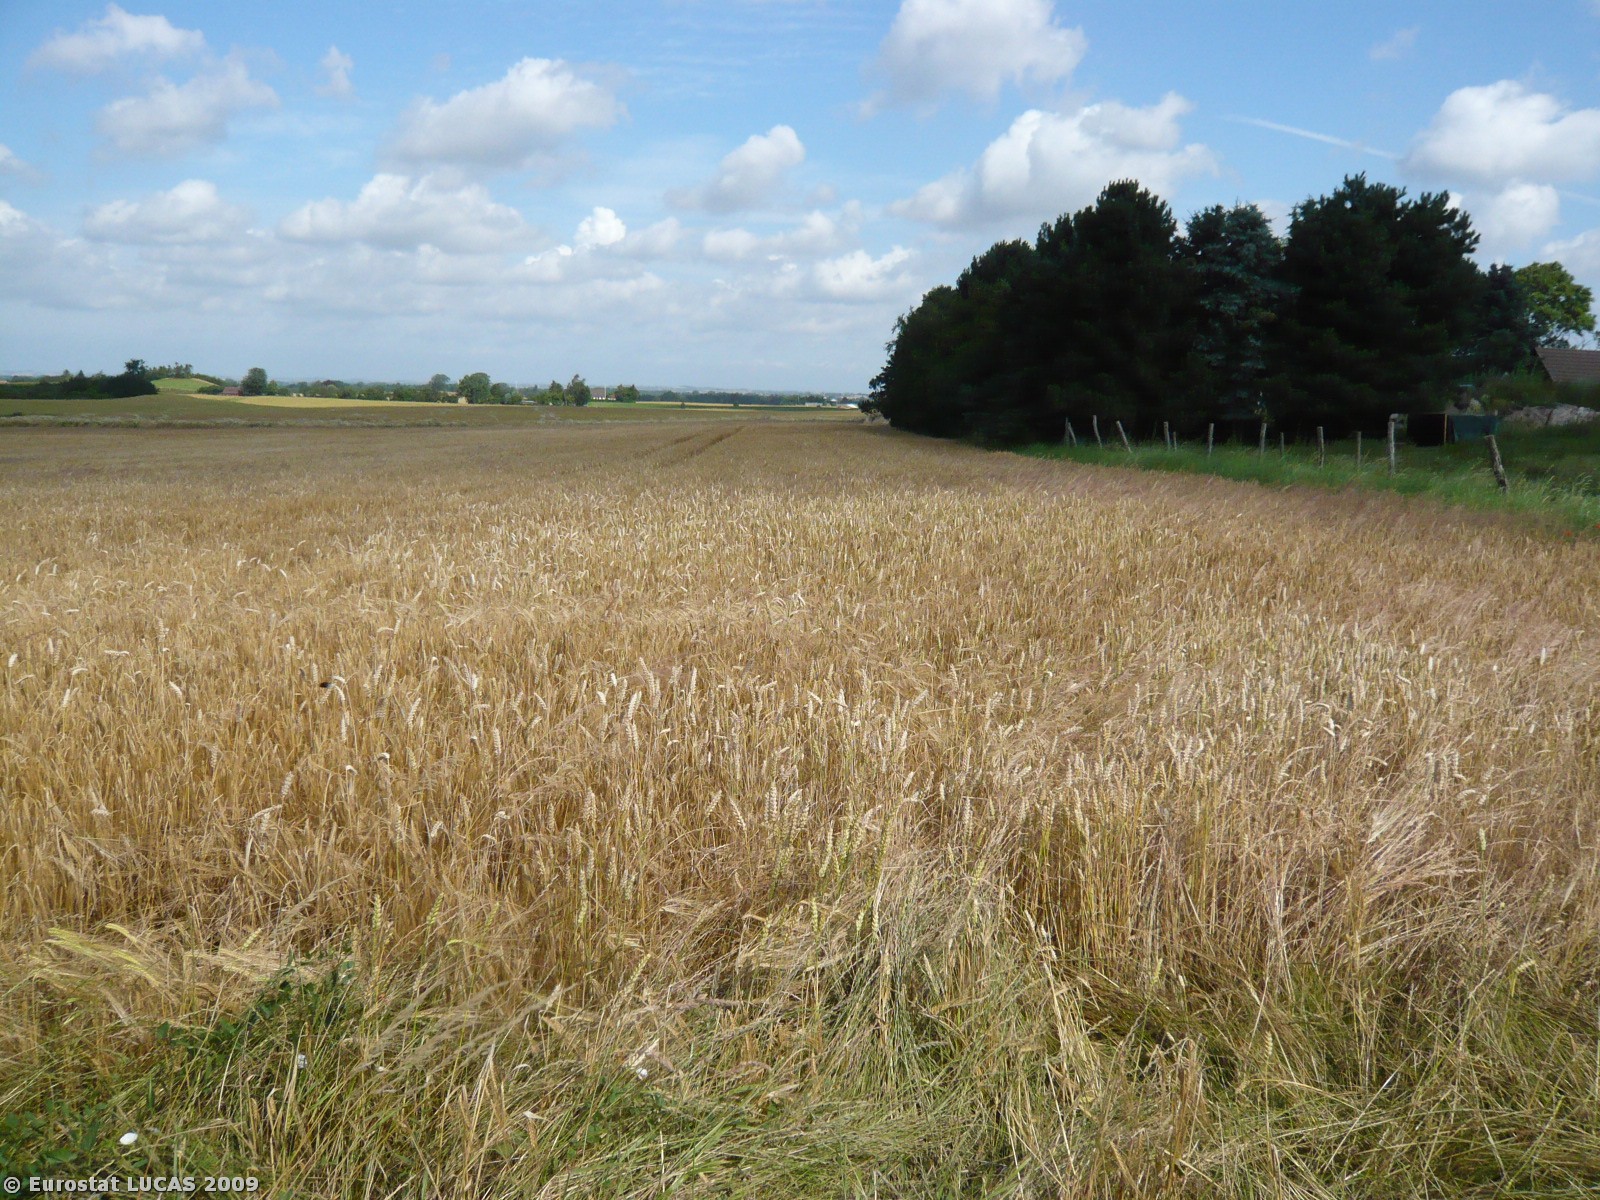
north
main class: Cropland
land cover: Common wheat
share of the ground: > 75 %
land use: Agriculture (excluding fallow land and kitchen gardens)
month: July
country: DK
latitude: 55.6739
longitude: 11.6363
